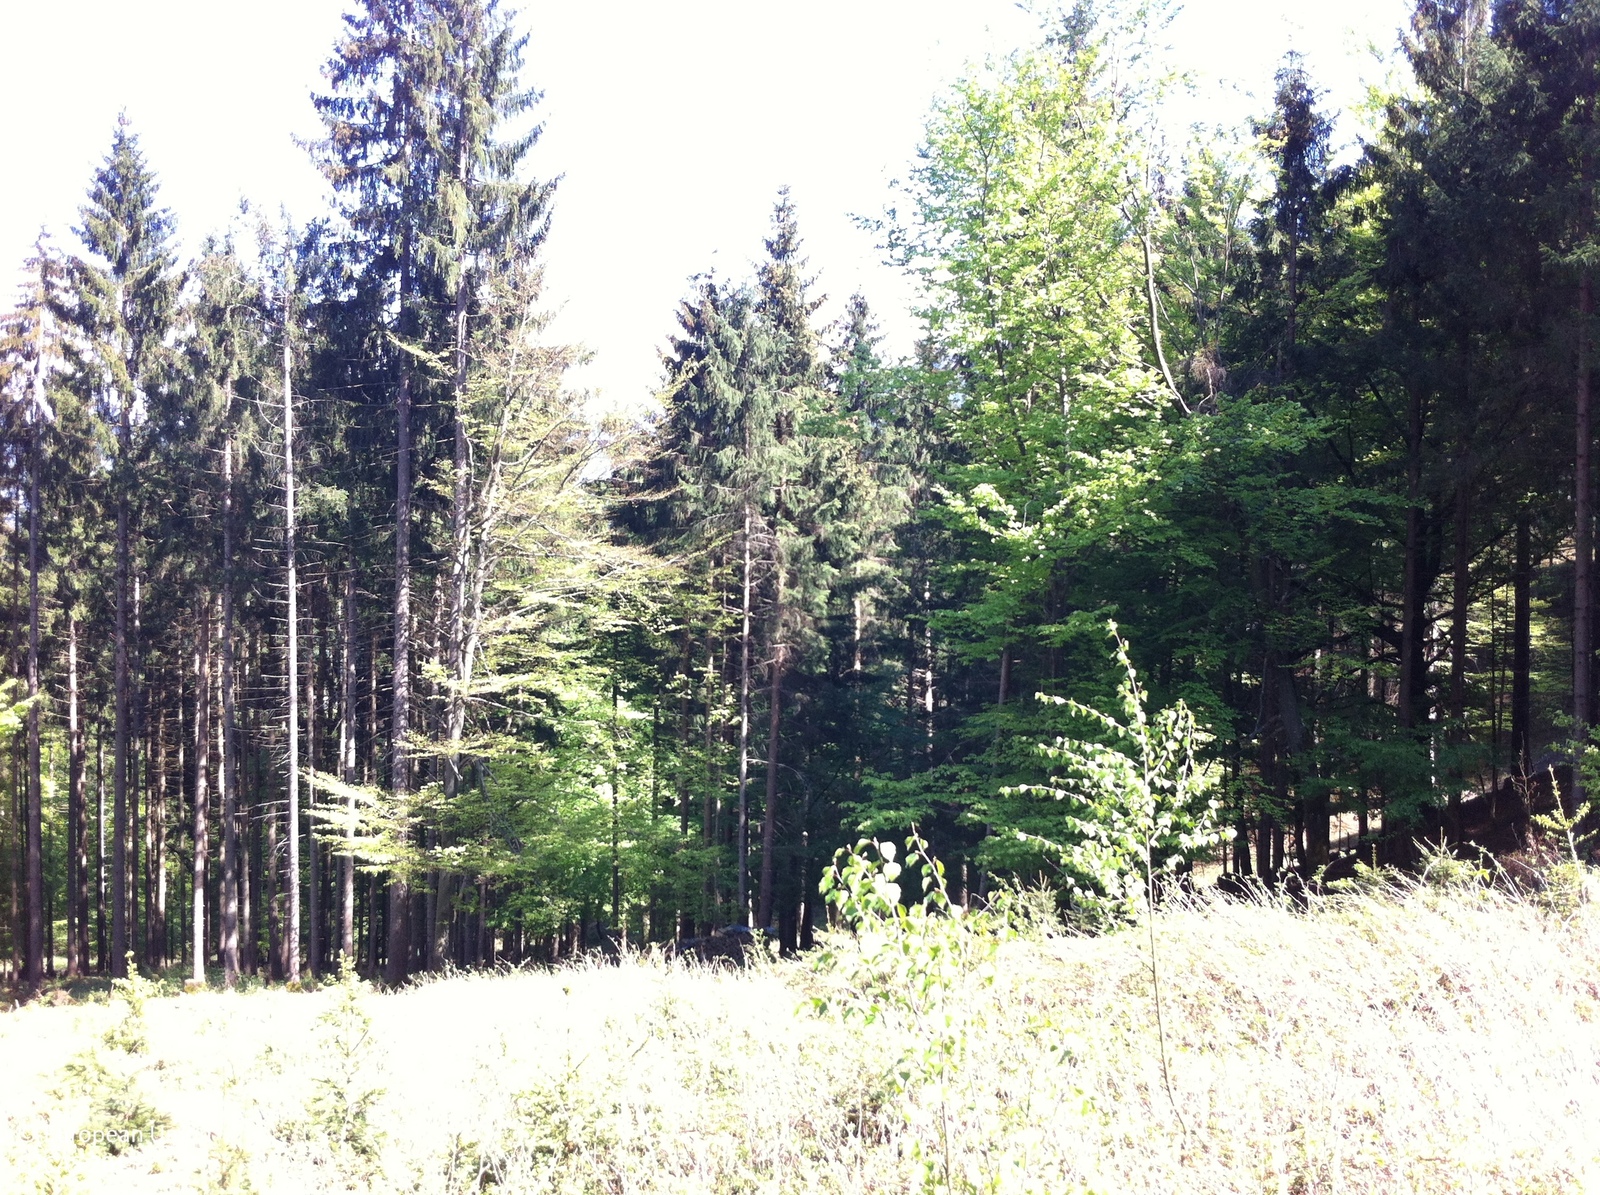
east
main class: Shrubland
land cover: Shrubland with sparse tree cover
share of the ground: > 75 %
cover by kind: unconsolidated bare surface 80 %, shrubs 10 %, coniferous forest trees 5 %, herbaceous plants 5 %
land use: Forestry
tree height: < 5 m
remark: Clear cut
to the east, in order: Shrubland with sparse tree cover; Spruce dominated coniferous woodland; Broadleaved woodland; Tracks; Broadleaved woodland; Spruce dominated mixed woodland
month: May
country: AT
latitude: 47.3994
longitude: 11.7608
